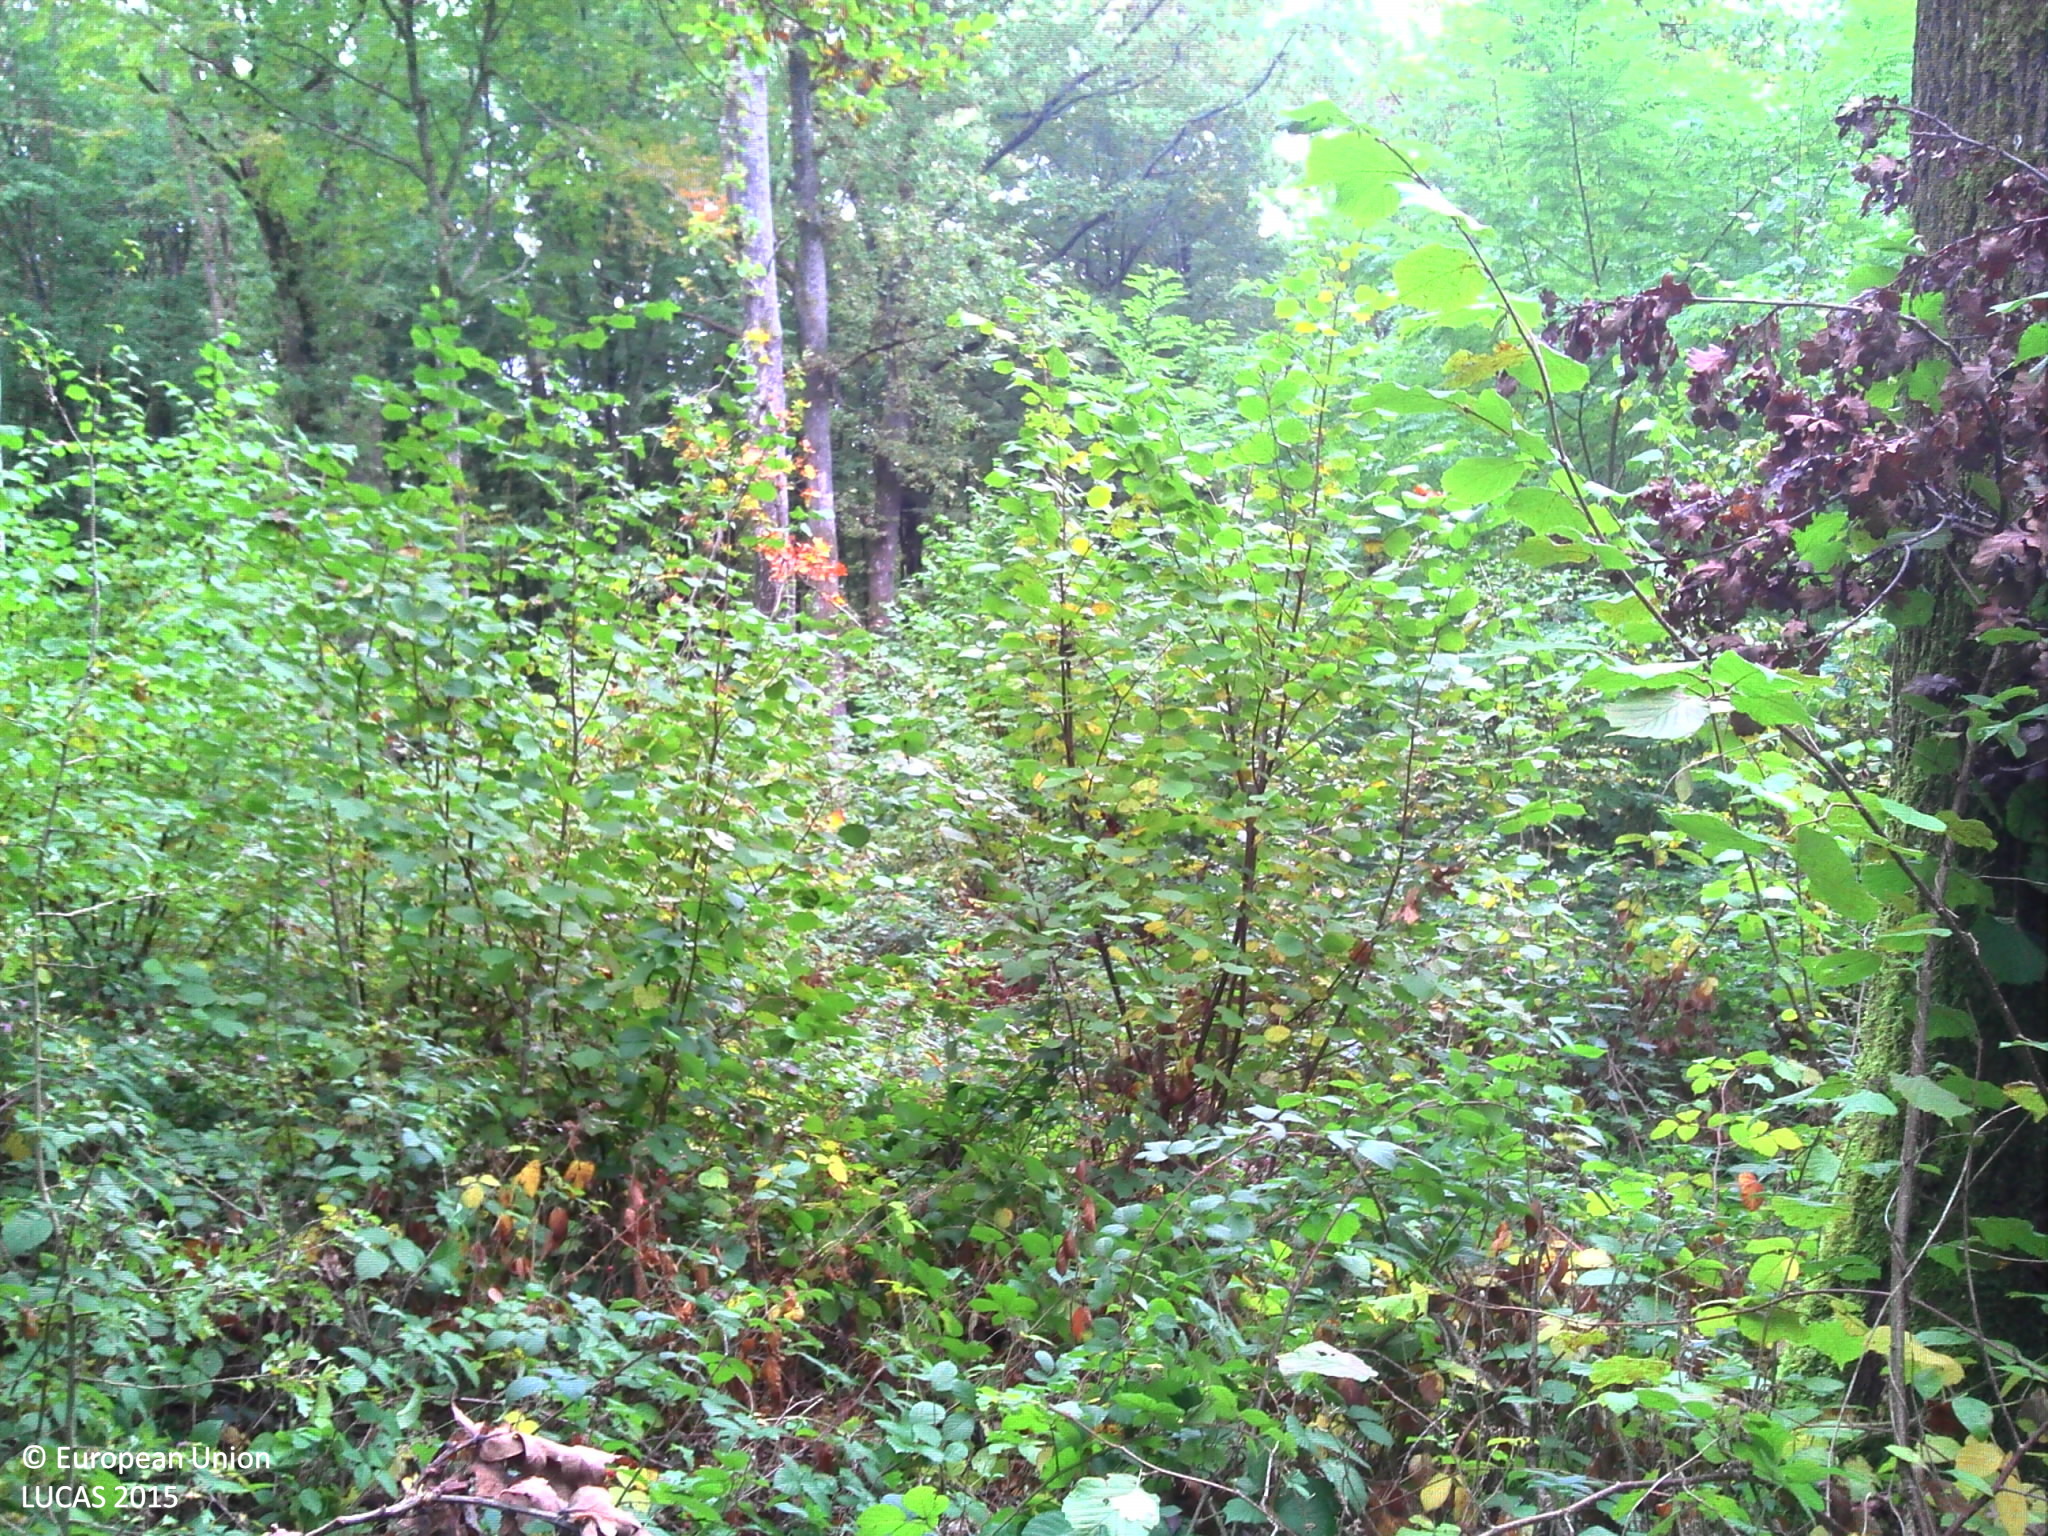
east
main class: Woodland
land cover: Broadleaved woodland
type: acidophilous oak and oak-birch forest
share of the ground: > 75 %
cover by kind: broadleaved forest trees 75 %, herbaceous plants 20 %, shrubs 5 %
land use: Forestry
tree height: > 5 m
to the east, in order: Broadleaved woodland; Ditches and canals; Broadleaved woodland; Ditches and canals; Broadleaved woodland; Grass margins; Paved roads, cycling and walking lanes; Grass margins; Ditches and canals; Broadleaved woodland
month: October
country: FR
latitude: 49.0325
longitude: 3.3315
